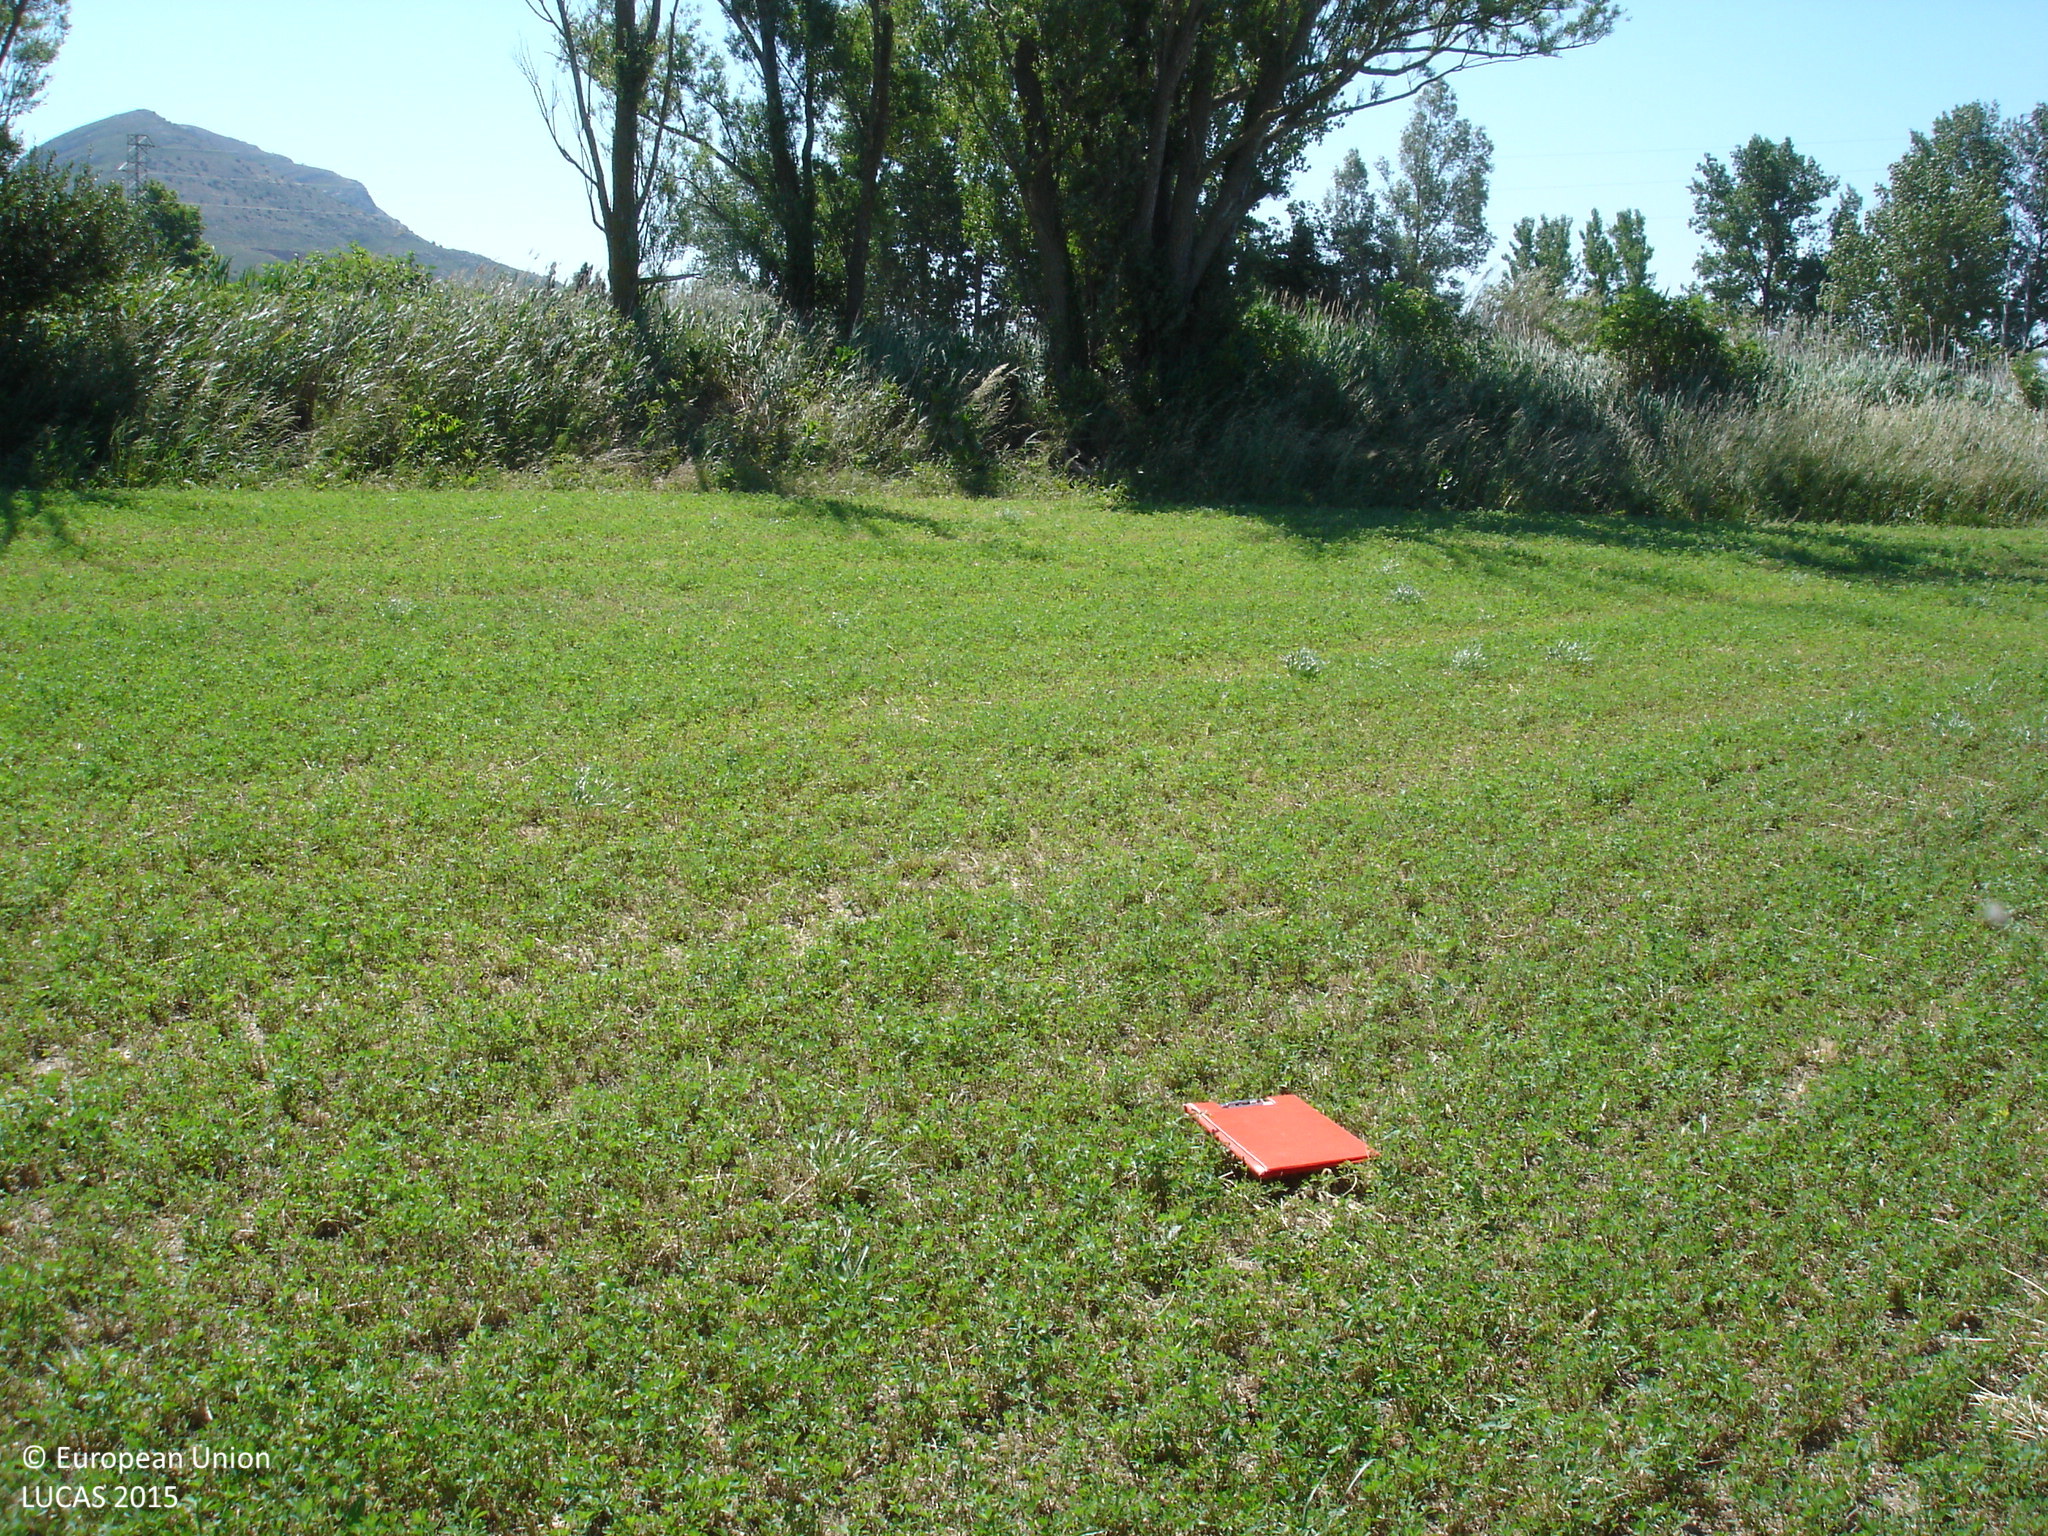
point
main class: Cropland
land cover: Lucerne
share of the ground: > 75 %
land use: Agriculture (excluding fallow land and kitchen gardens)
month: May
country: ES
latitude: 42.0735
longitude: 3.0897
